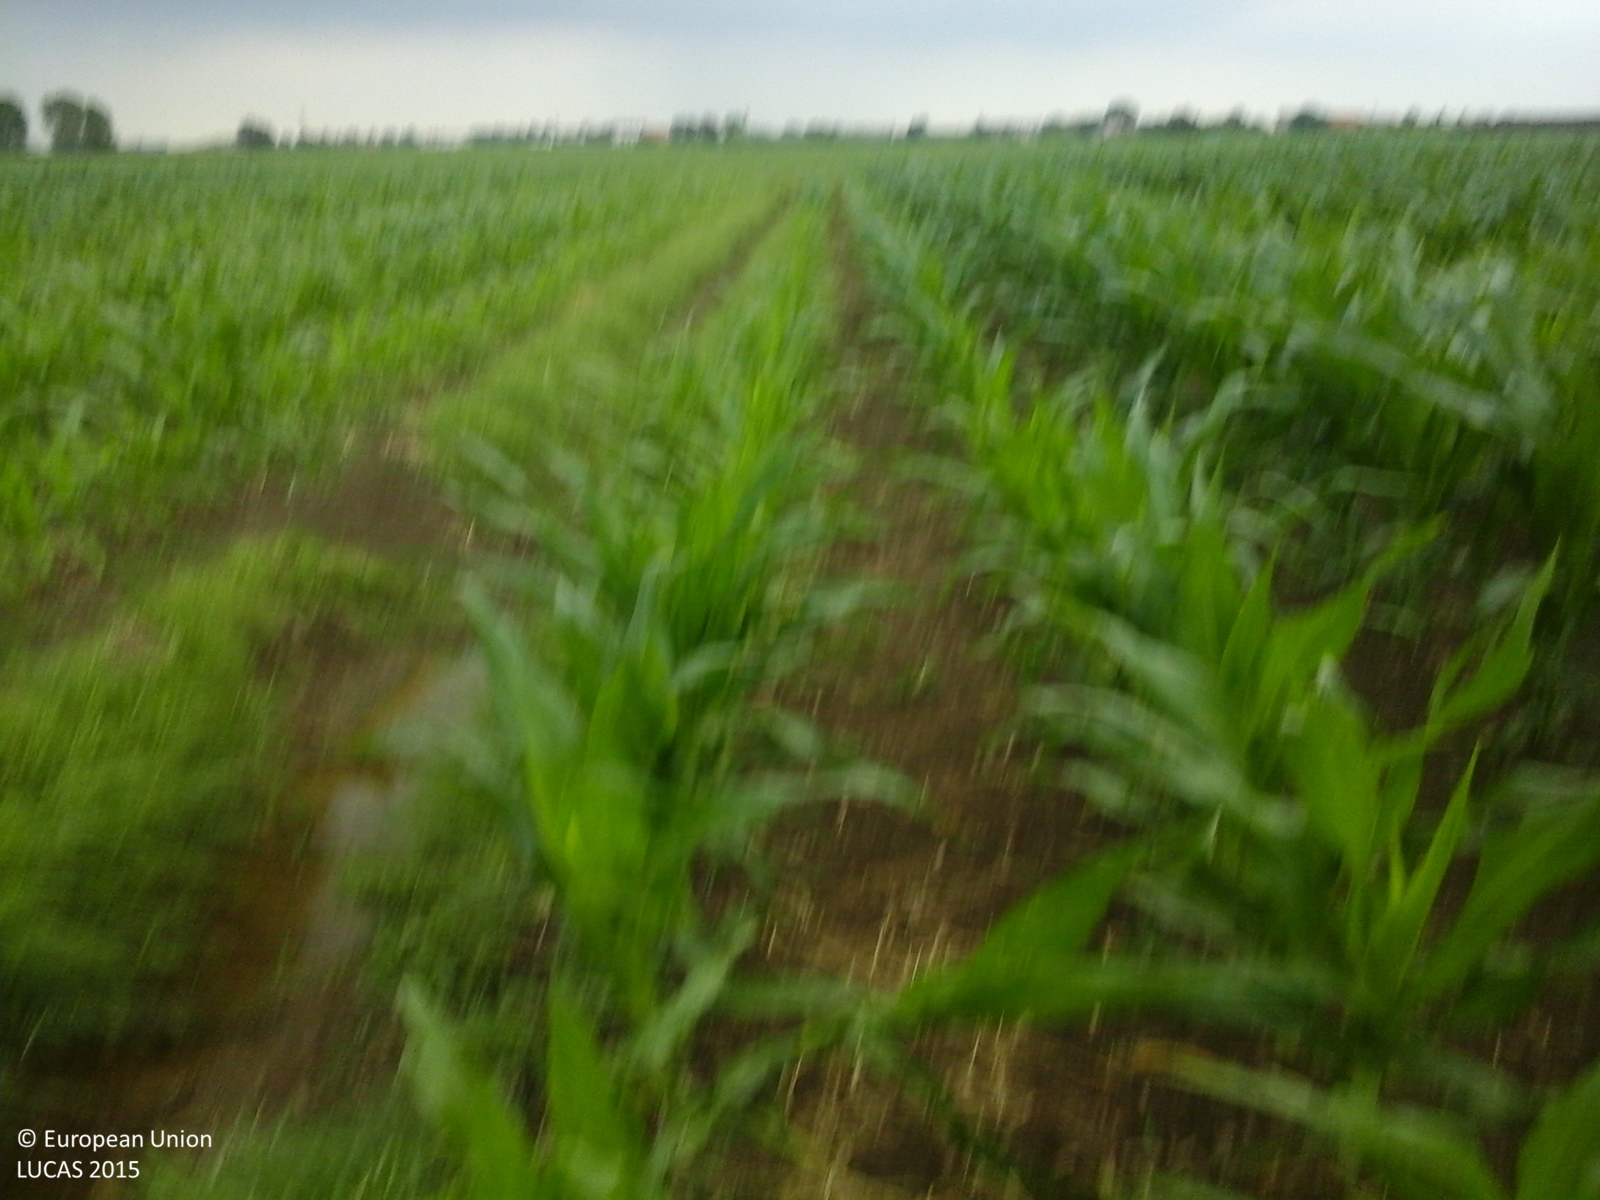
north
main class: Cropland
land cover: Maize
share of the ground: > 75 %
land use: Agriculture (excluding fallow land and kitchen gardens)
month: June
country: IT
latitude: 45.7401
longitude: 12.7082
